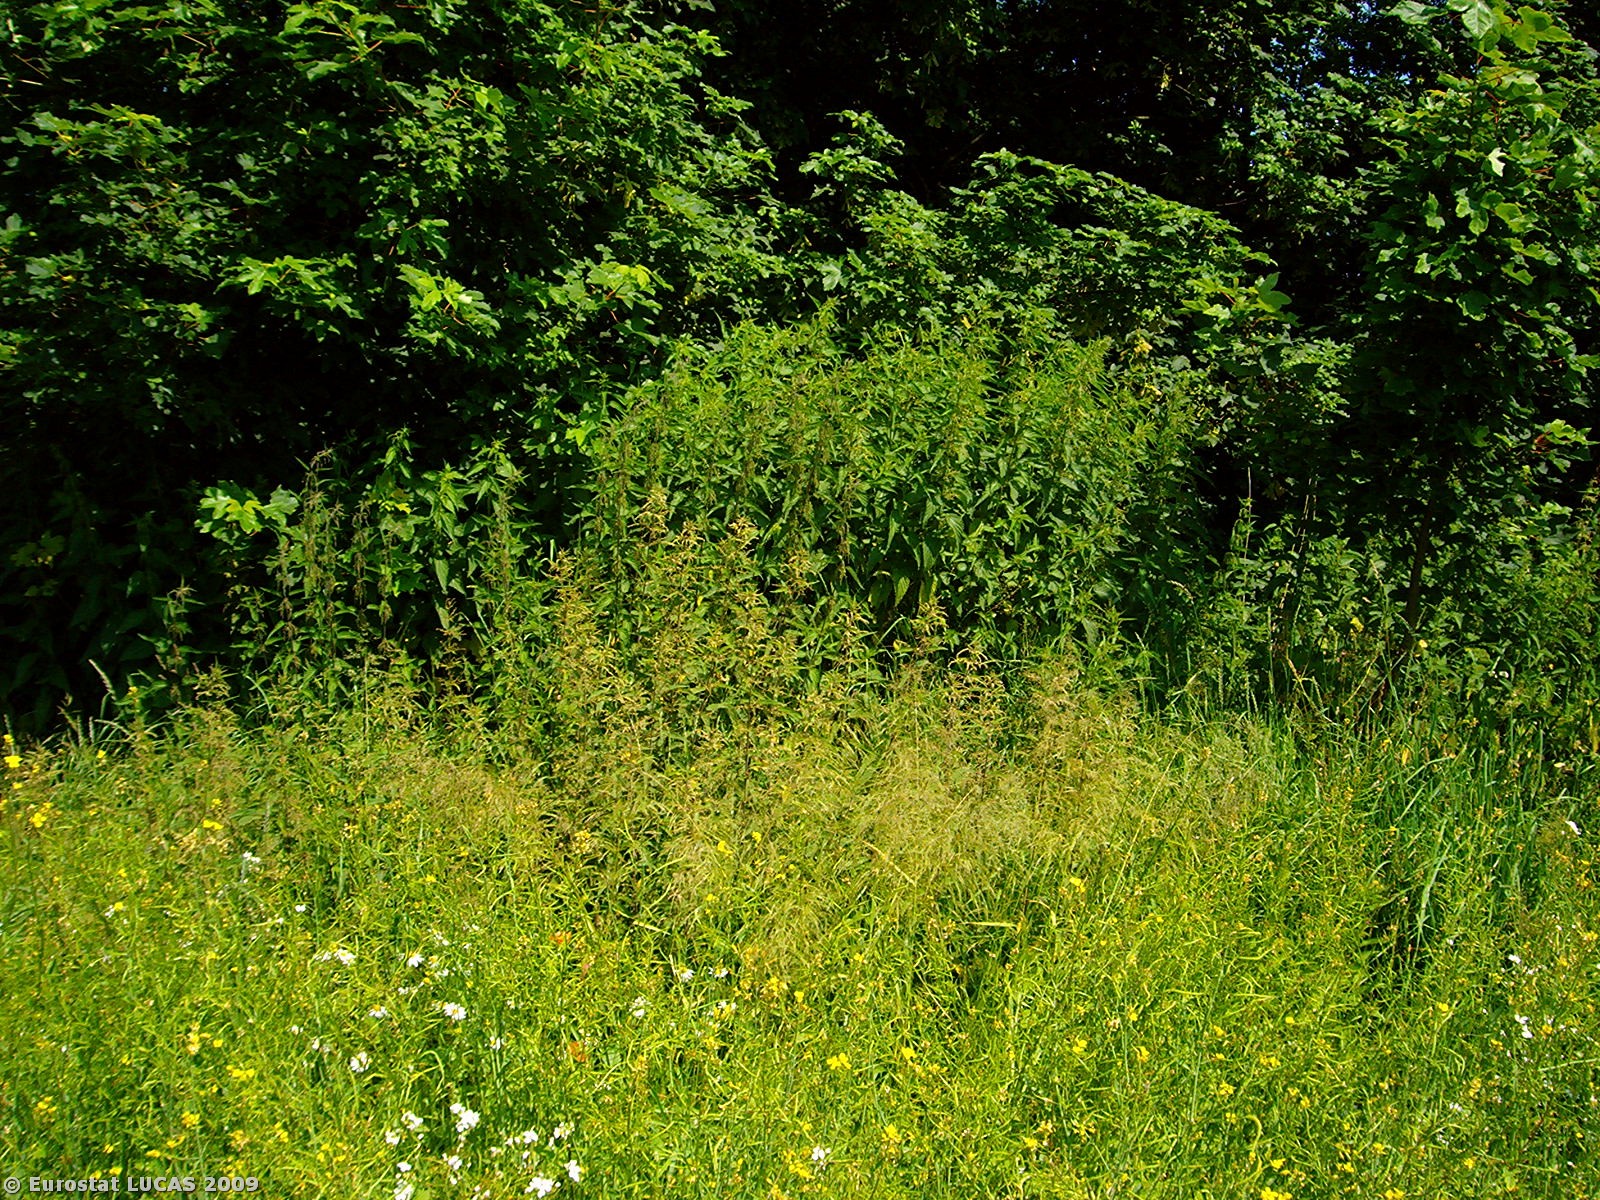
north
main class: Cropland
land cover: Triticale
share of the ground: > 75 %
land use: Agriculture (excluding fallow land and kitchen gardens)
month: July
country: PL
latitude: 53.5467
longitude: 15.5119
